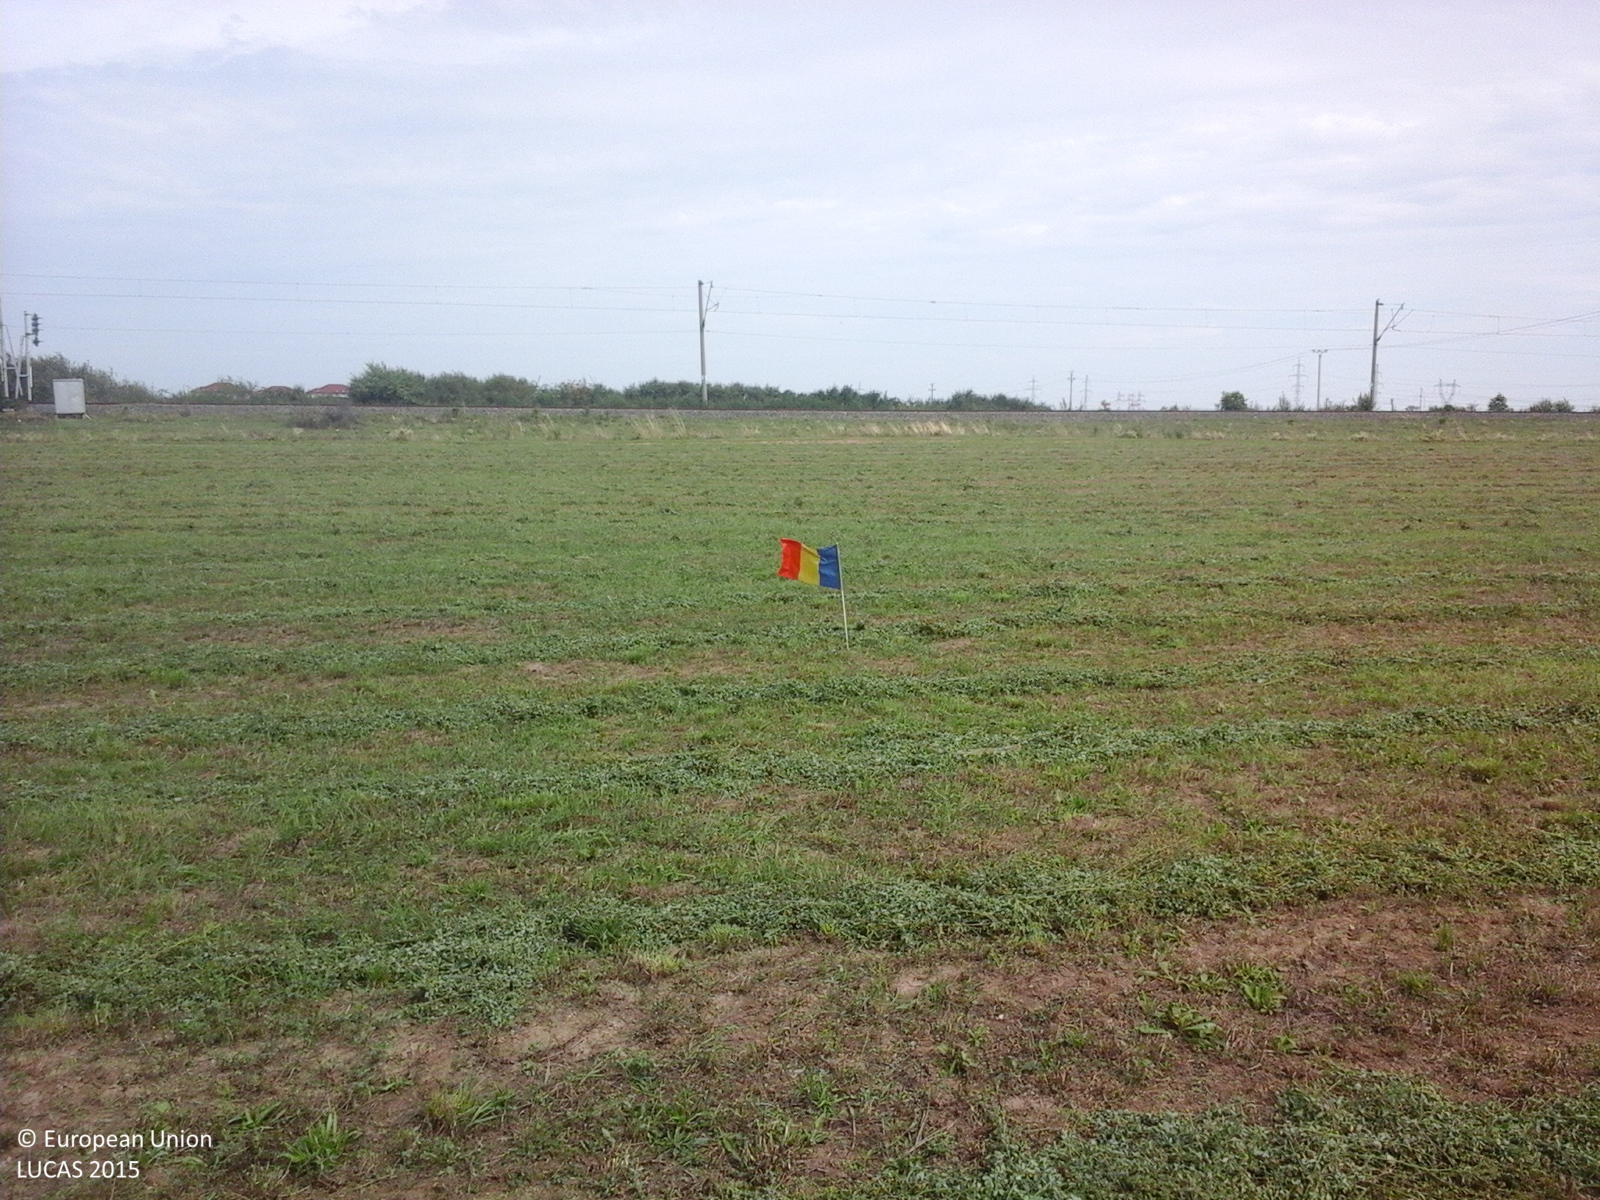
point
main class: Cropland
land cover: Lucerne
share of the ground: 50 - 75 %
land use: Agriculture (excluding fallow land and kitchen gardens)
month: August
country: RO
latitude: 46.1615
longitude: 21.3657
